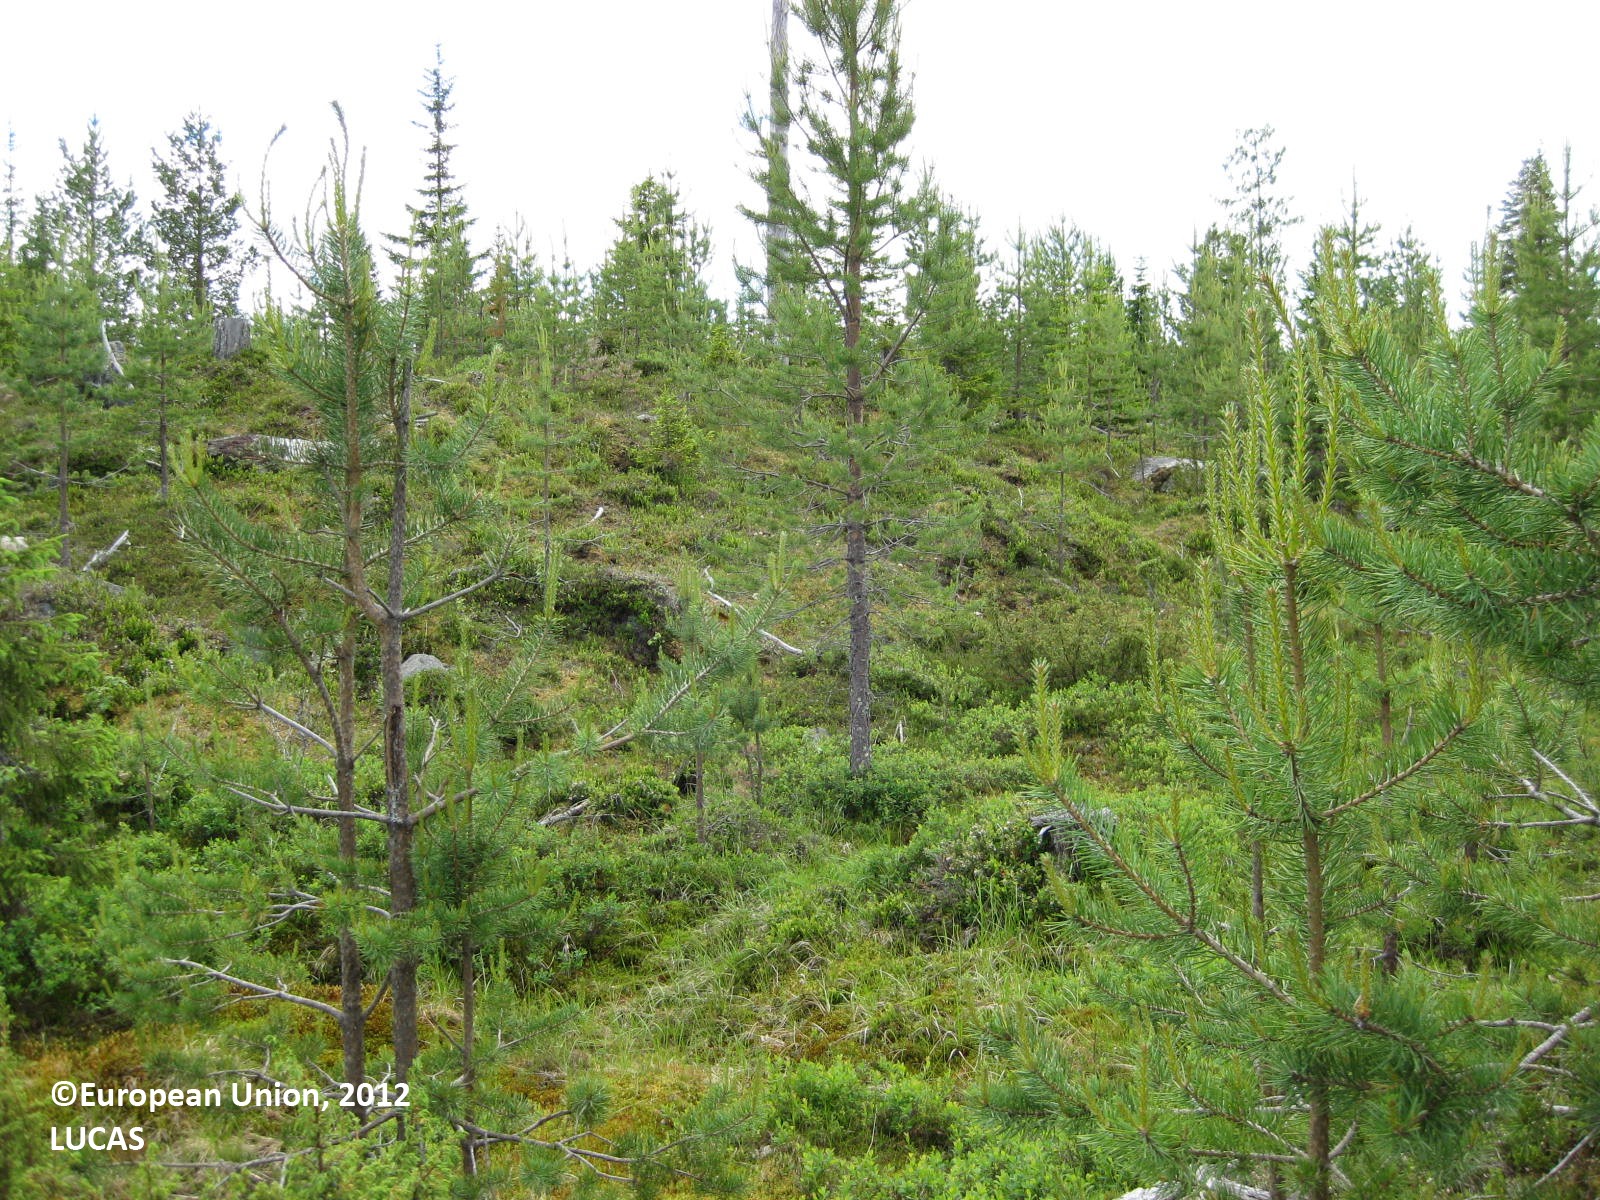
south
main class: Woodland
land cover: Pine dominated coniferous woodland
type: boreal forest
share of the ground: 50 - 75 %
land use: Forestry
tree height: > 5 m
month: July
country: FI
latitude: 65.4805
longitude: 29.3027
